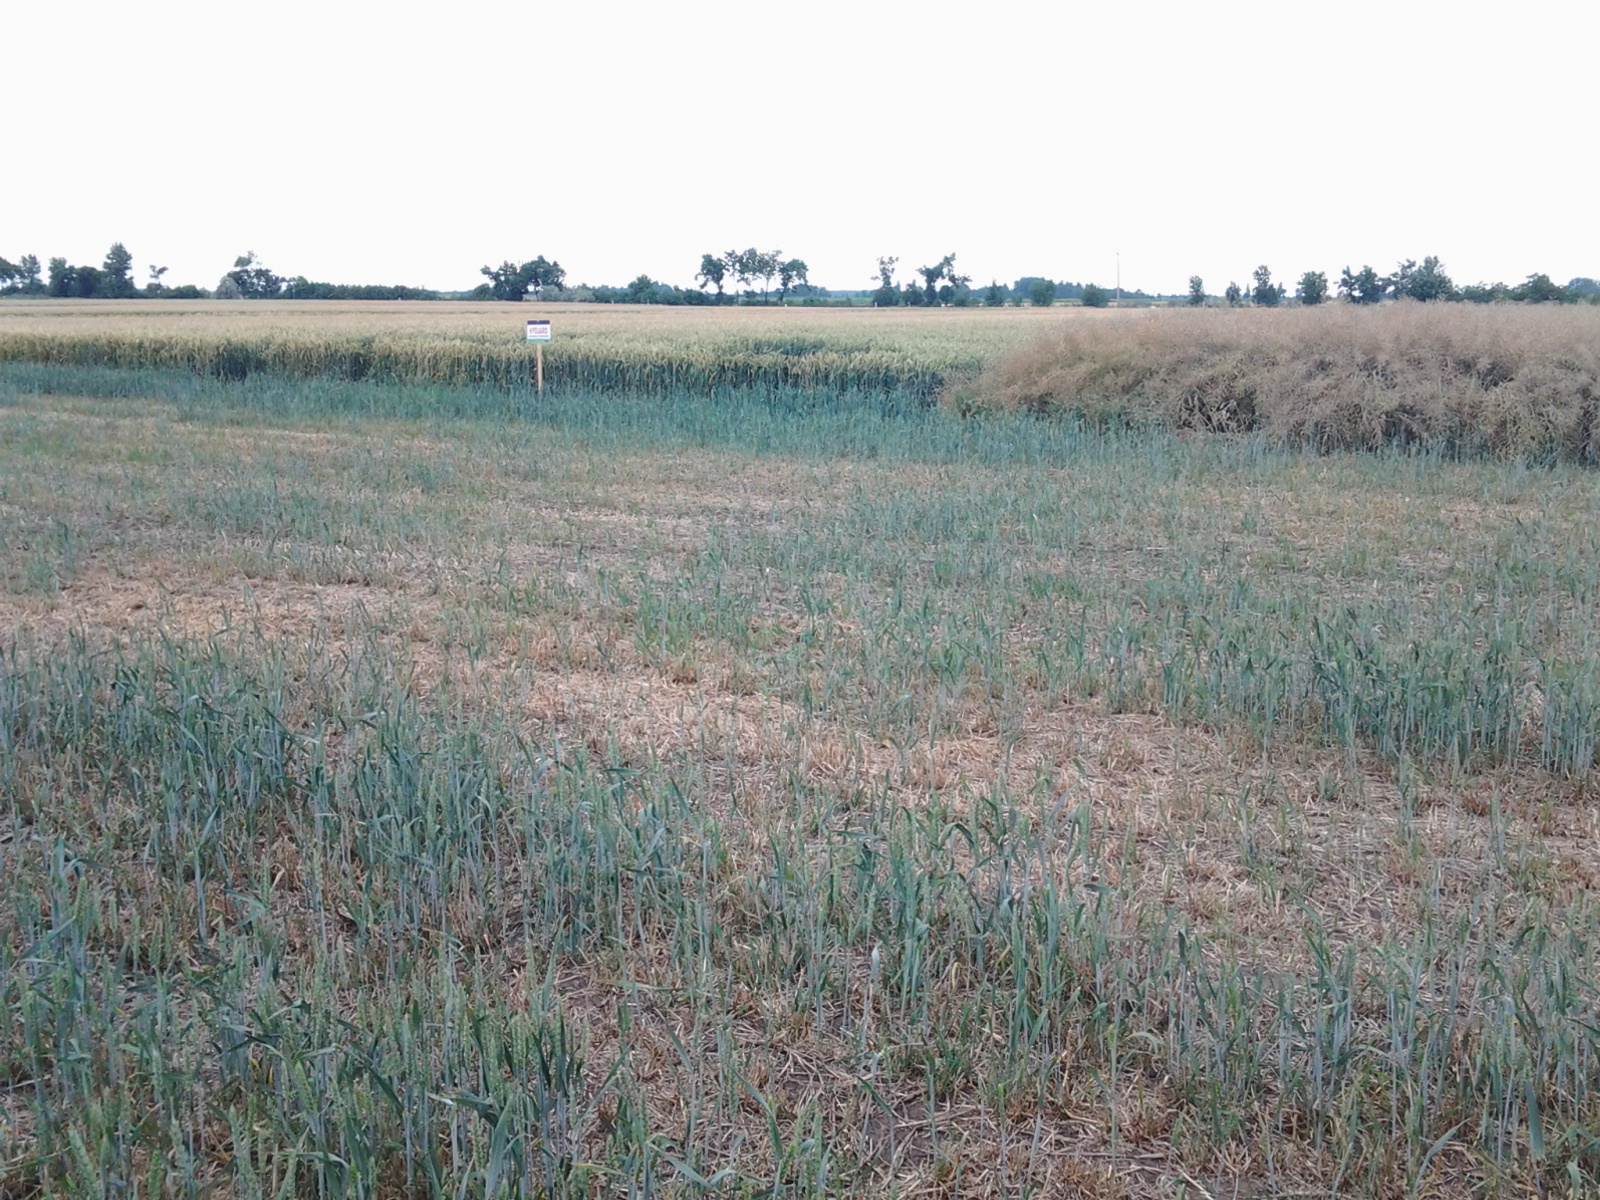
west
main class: Cropland
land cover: Rape and turnip rape
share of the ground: > 75 %
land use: Agriculture (excluding fallow land and kitchen gardens)
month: June
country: HU
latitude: 47.6258
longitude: 19.9664
